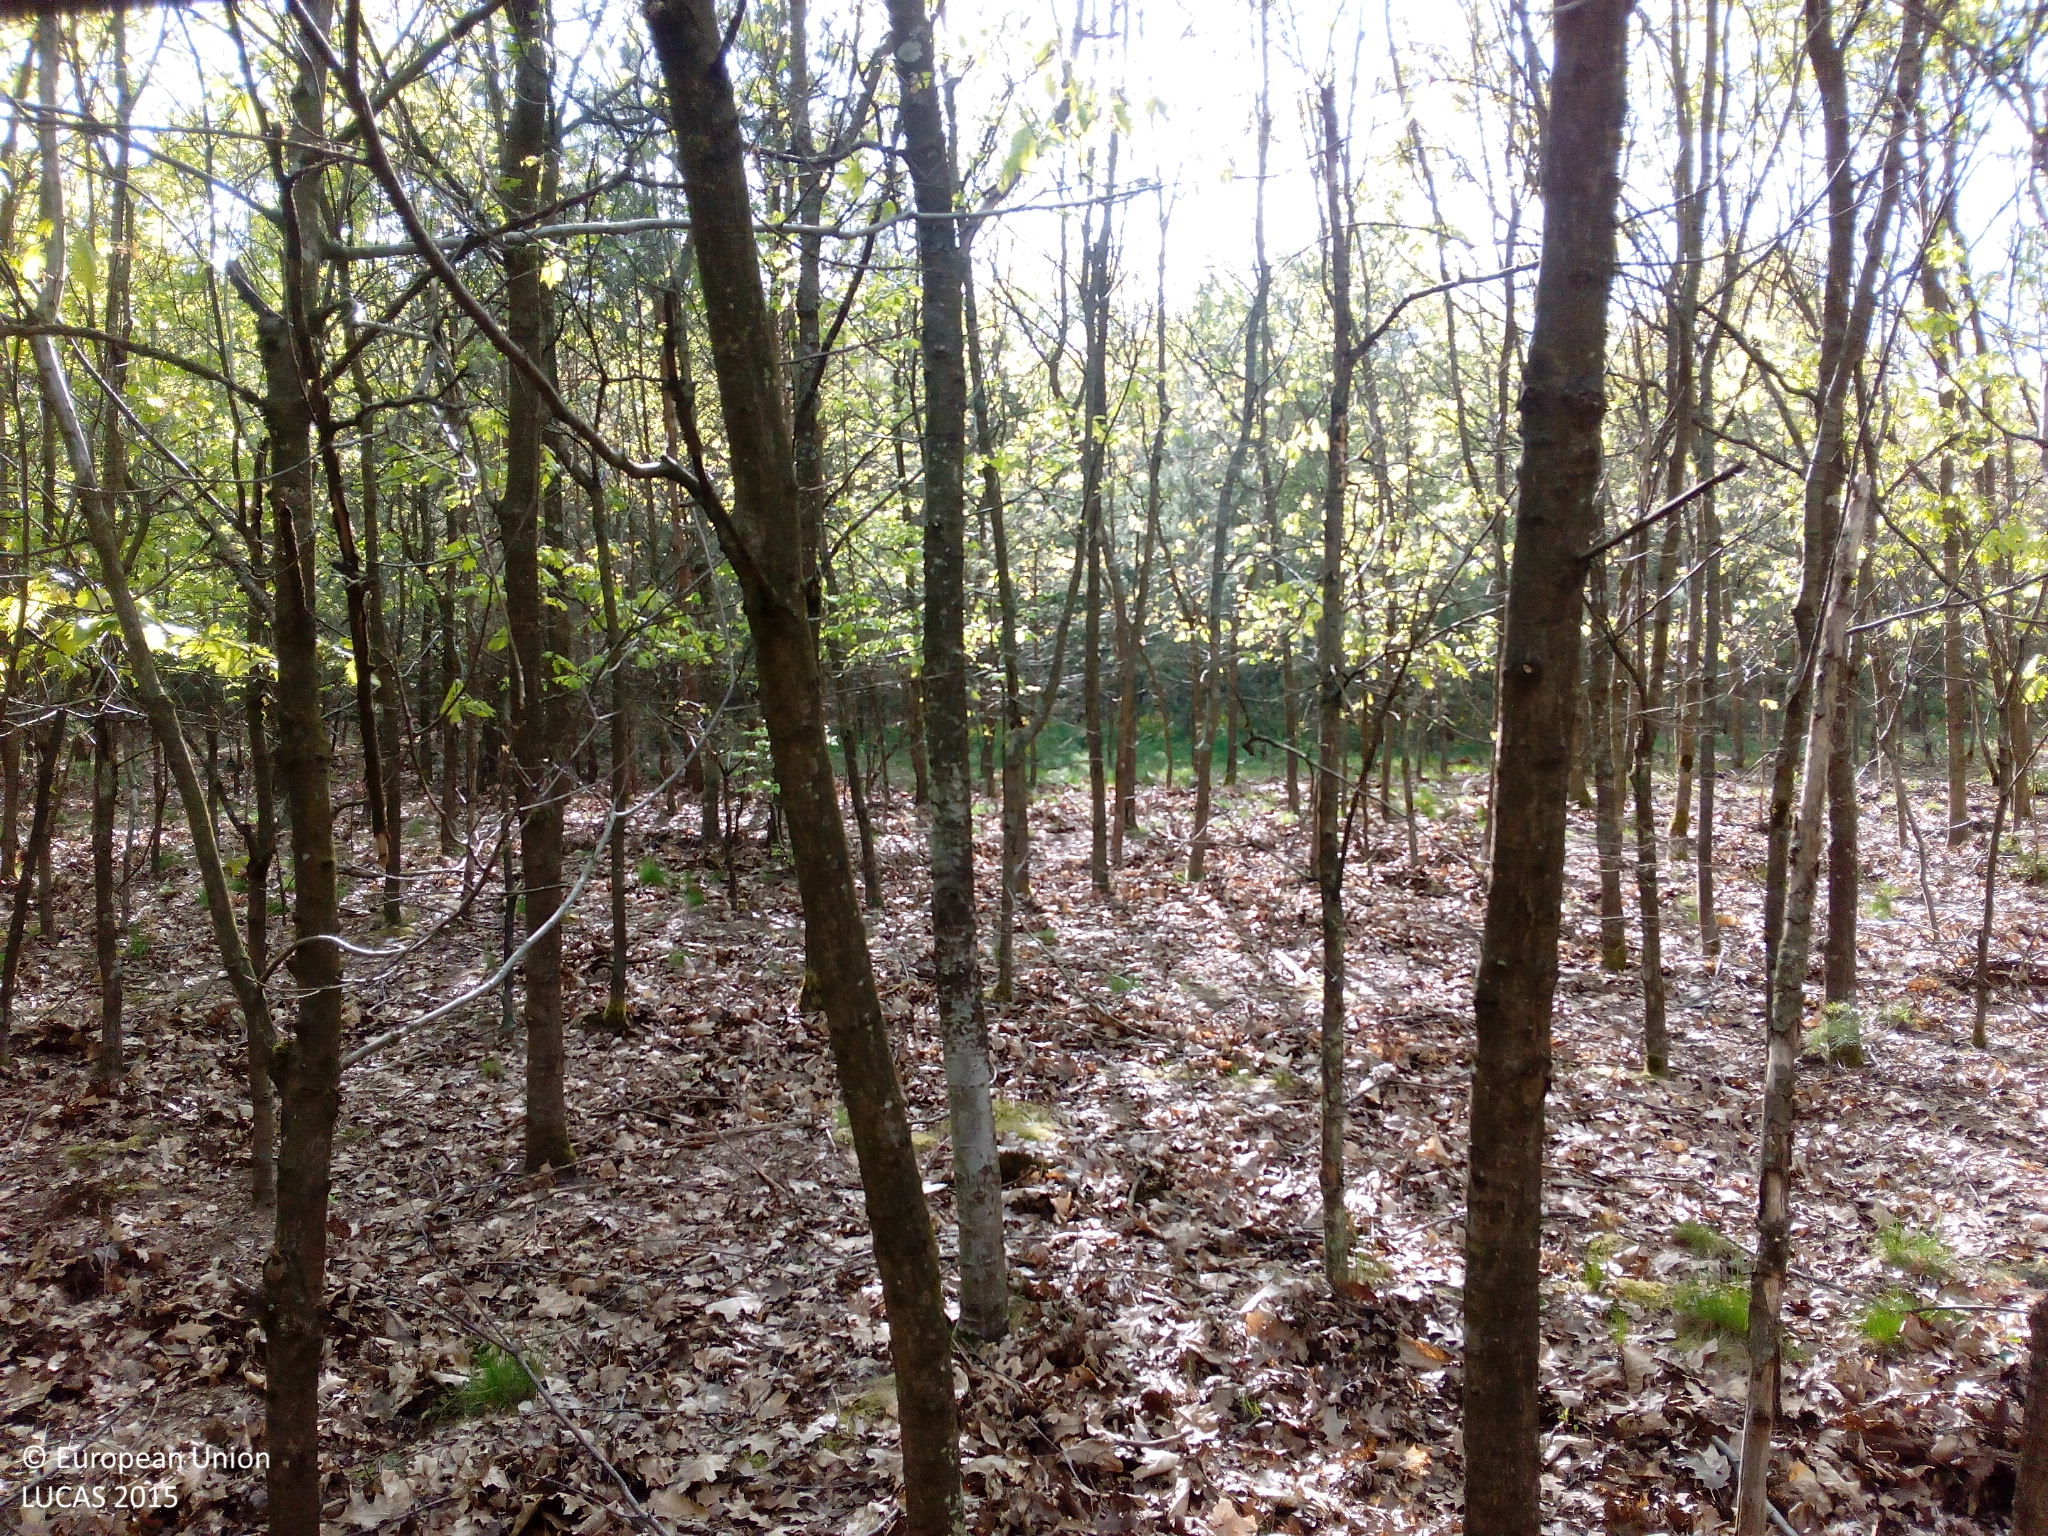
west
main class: Woodland
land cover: Broadleaved woodland
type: acidophilous oak and oak-birch forest
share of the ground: 50 - 75 %
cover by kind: broadleaved forest trees 70 %, unconsolidated bare surface 20 %, herbaceous plants 5 %, lichens and mosses 5 %
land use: Forestry
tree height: > 5 m
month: May
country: DE
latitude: 49.6354
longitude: 8.5466
